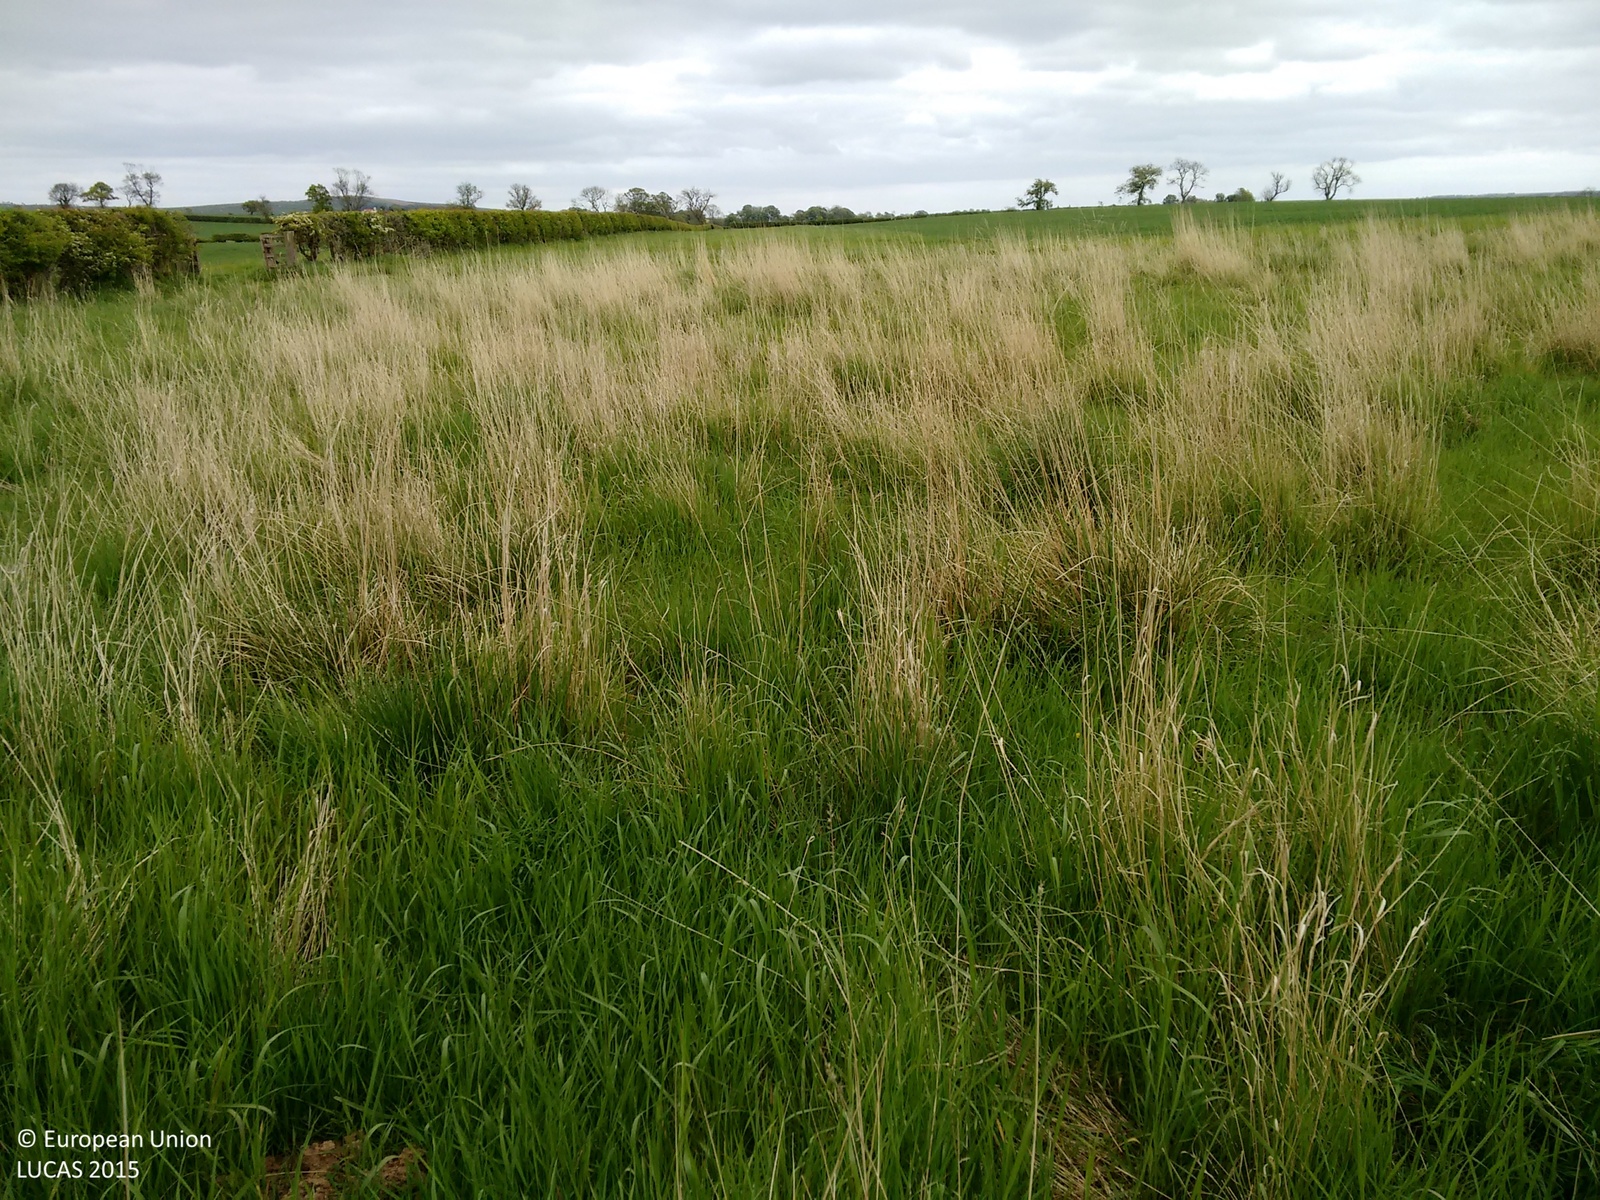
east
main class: Grassland
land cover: Grassland without tree/shrub cover
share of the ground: > 75 %
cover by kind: herbaceous plants 100 %
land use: Agriculture (excluding fallow land and kitchen gardens)
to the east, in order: Fences; Abandoned hedges; Grassland without tree/shrub cover; Tracks; Barley; Grassland without tree/shrub cover
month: May
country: GB
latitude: 55.7743
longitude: -2.1220
